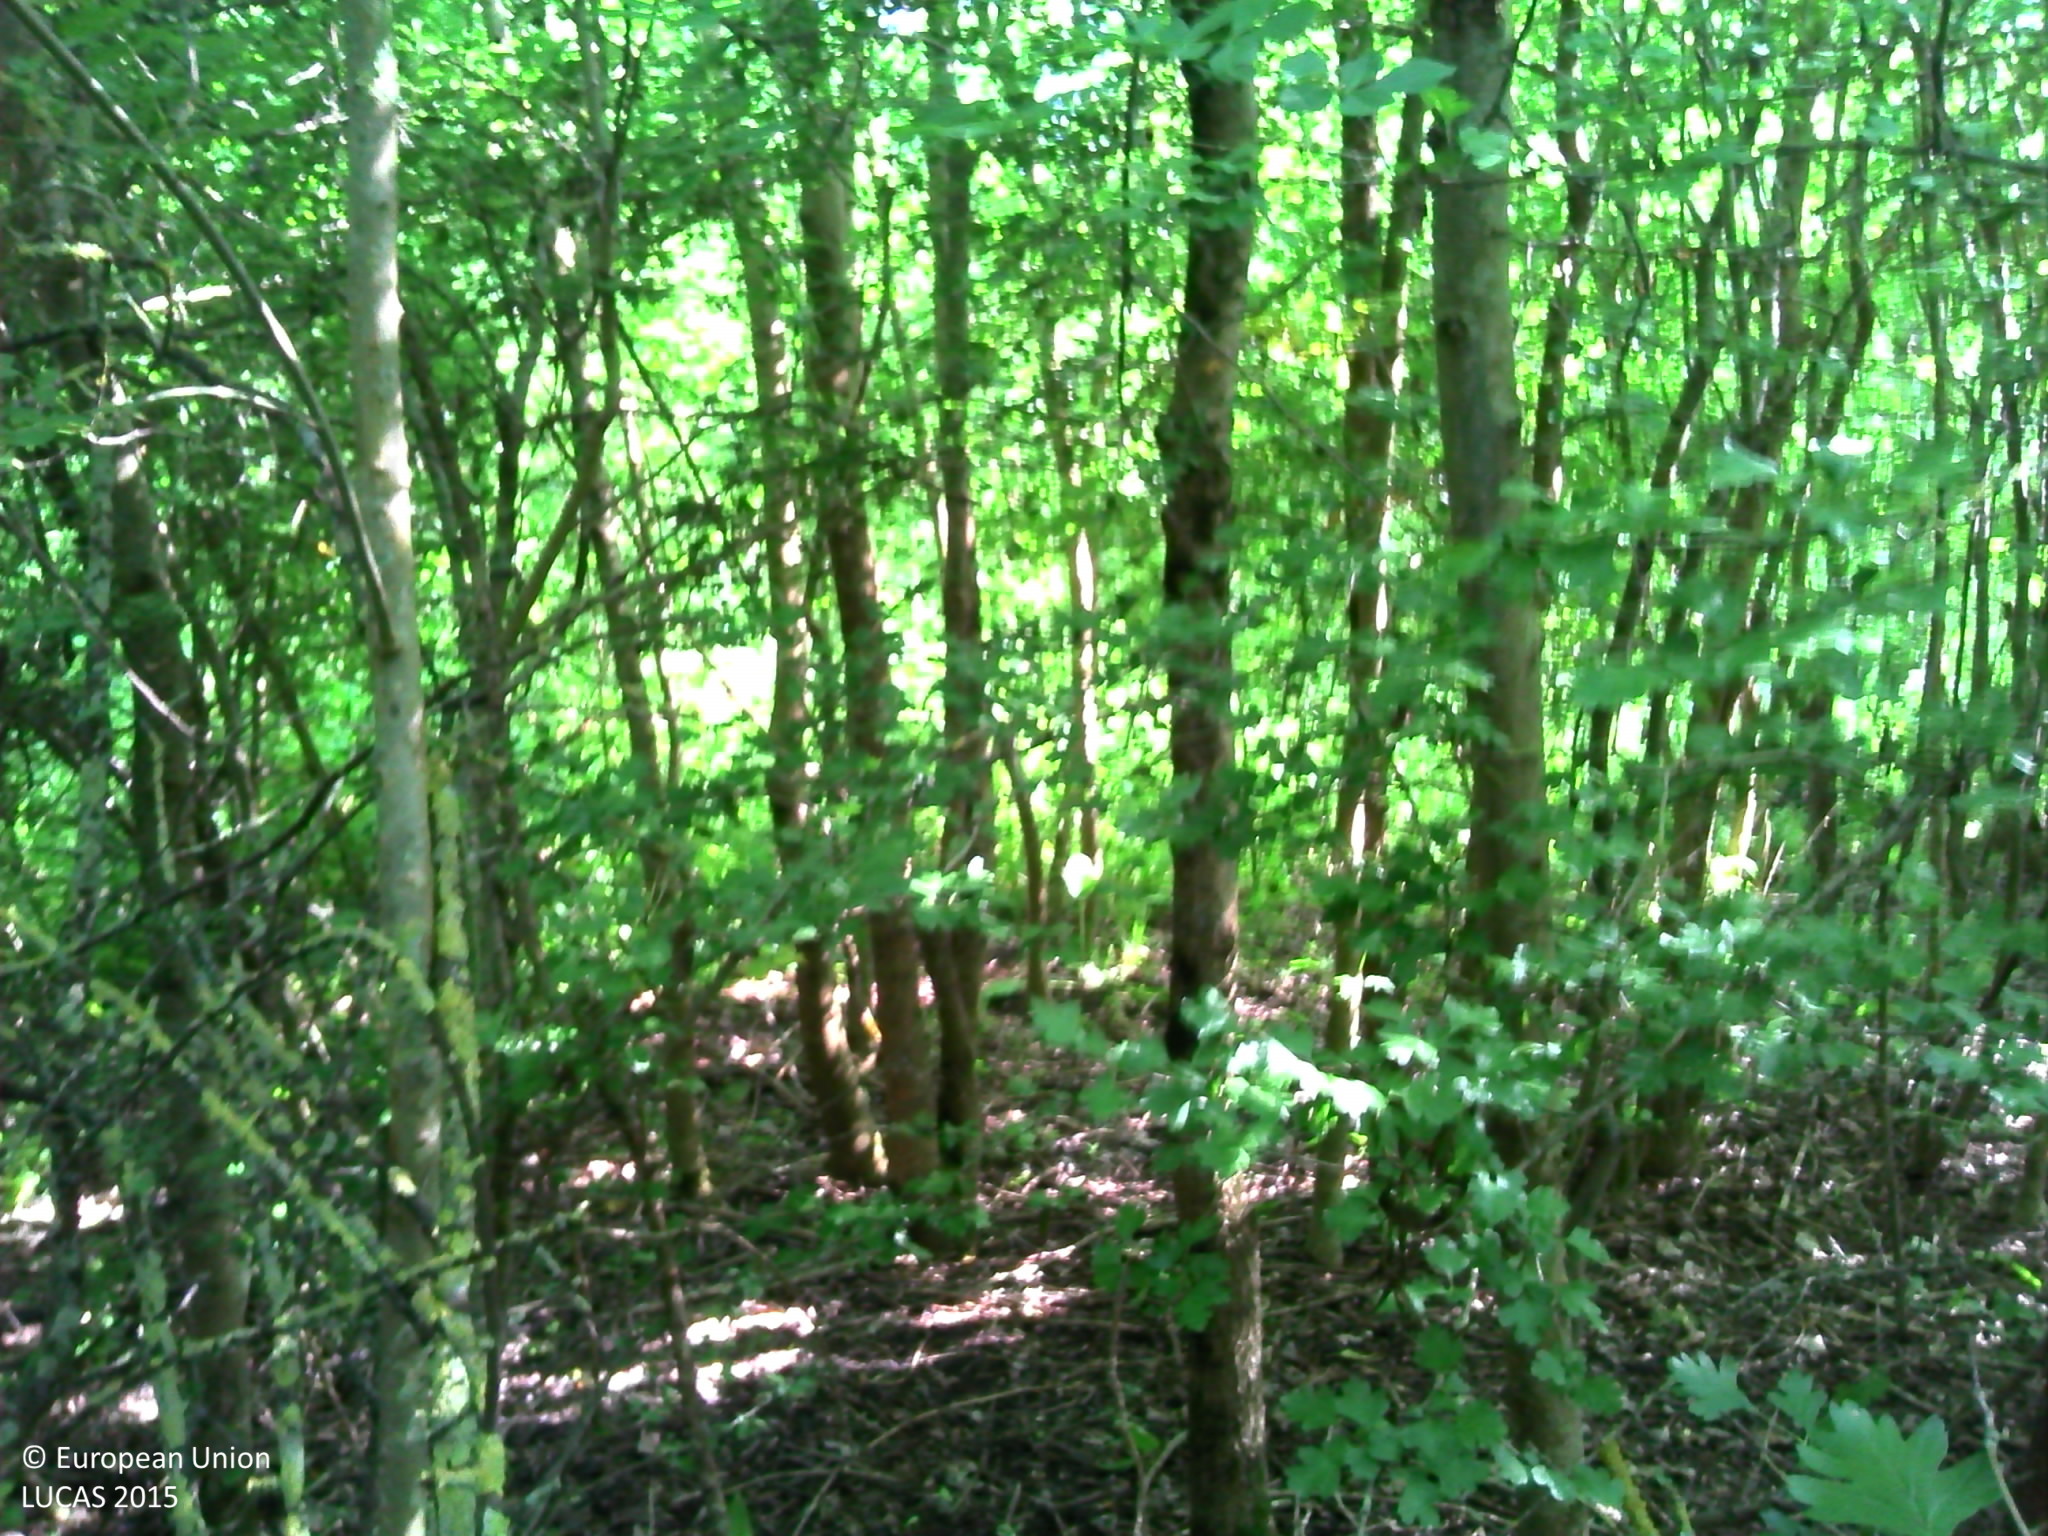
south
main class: Woodland
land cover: Broadleaved woodland
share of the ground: > 75 %
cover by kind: broadleaved forest trees 100 %
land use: Forestry
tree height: > 5 m
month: June
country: FR
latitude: 46.3120
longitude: -0.7937
